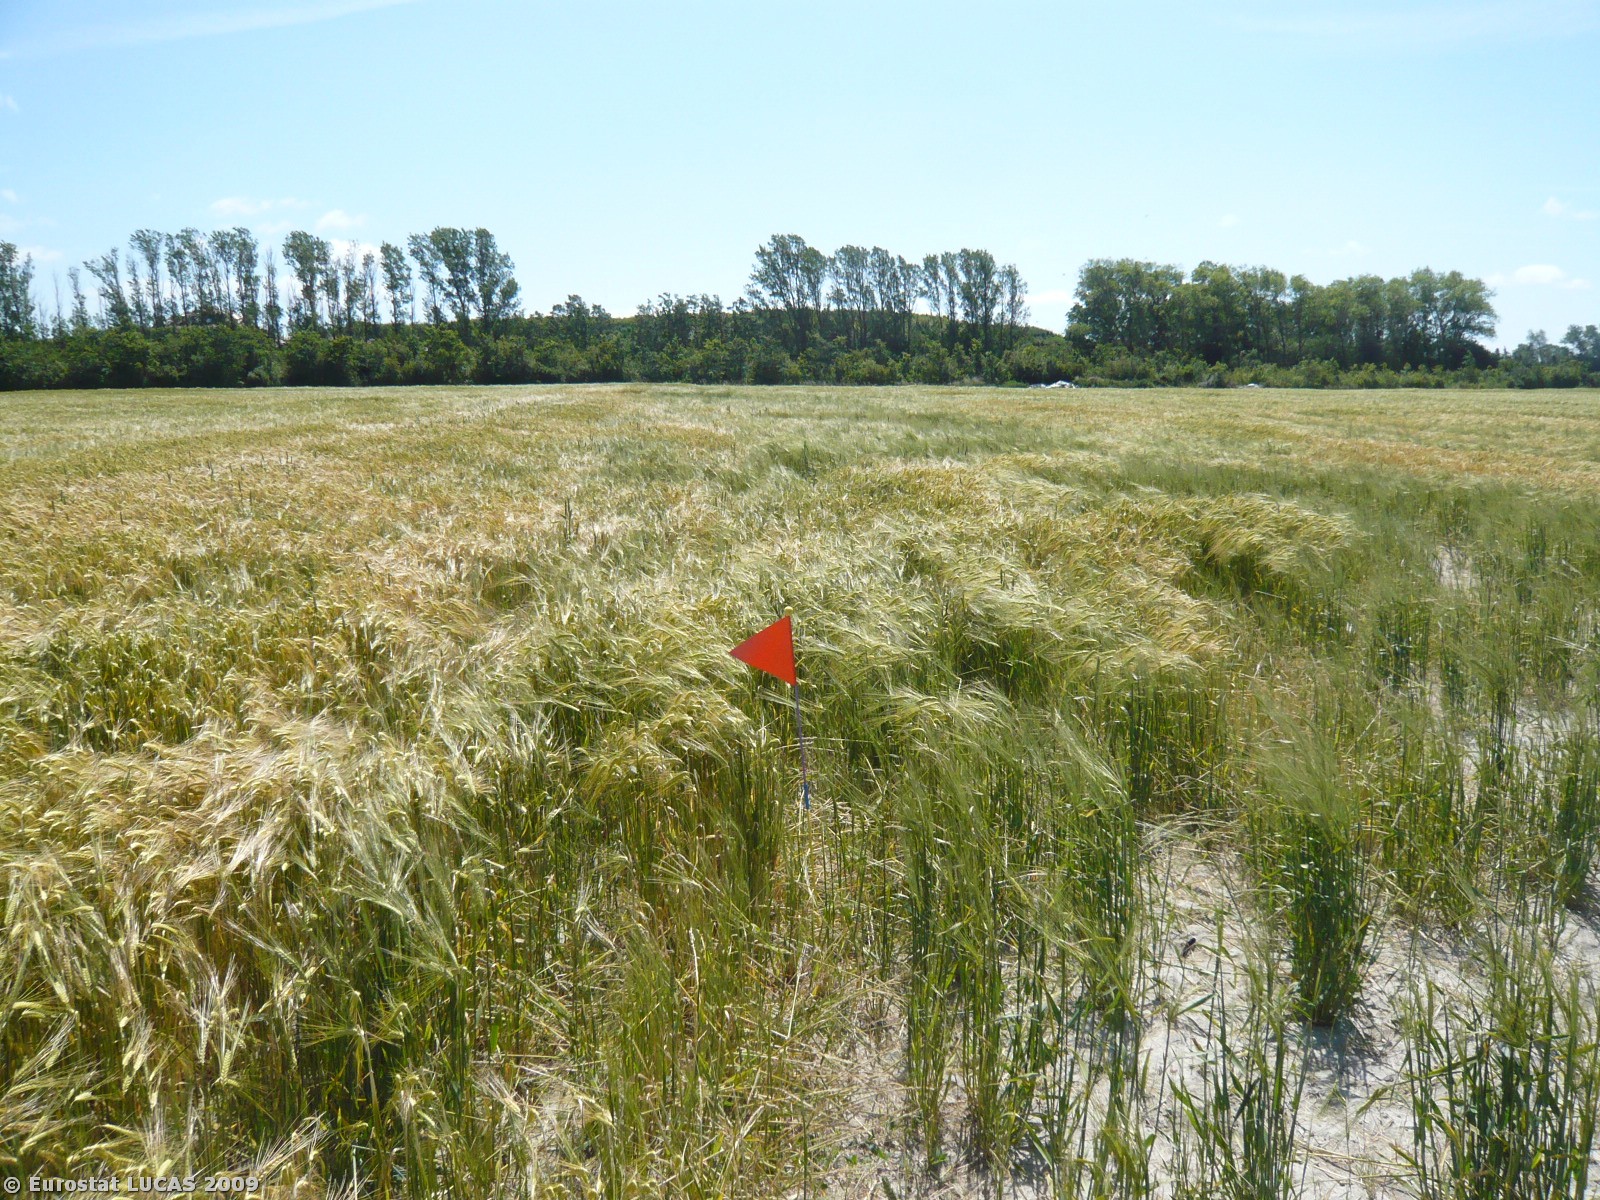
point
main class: Cropland
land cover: Barley
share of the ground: 50 - 75 %
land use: Agriculture (excluding fallow land and kitchen gardens)
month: June
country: DK
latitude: 54.7069
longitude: 11.3183
